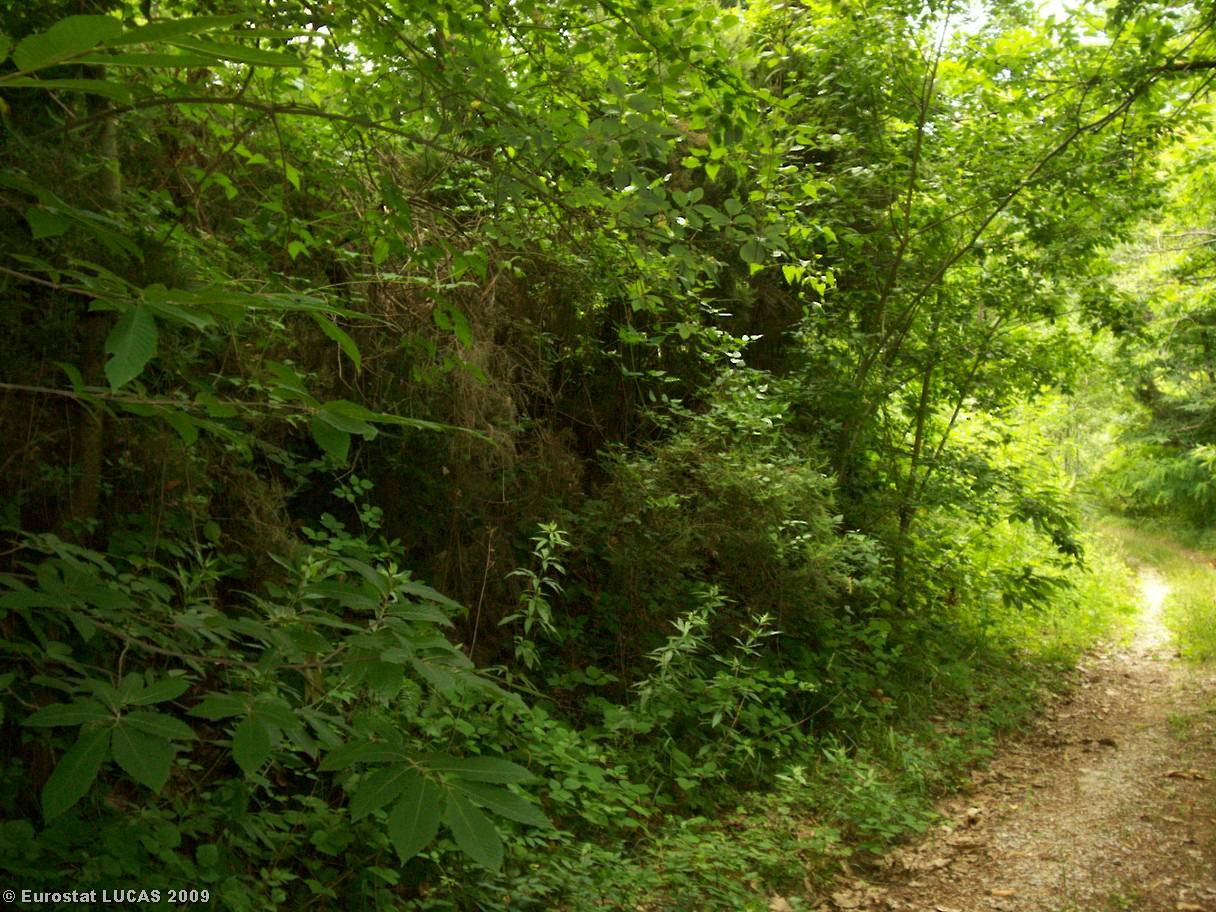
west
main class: Woodland
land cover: Broadleaved woodland
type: thermophilous deciduous forest
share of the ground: > 75 %
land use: Forestry
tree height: > 5 m
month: June
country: IT
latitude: 43.8990
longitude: 10.3353
